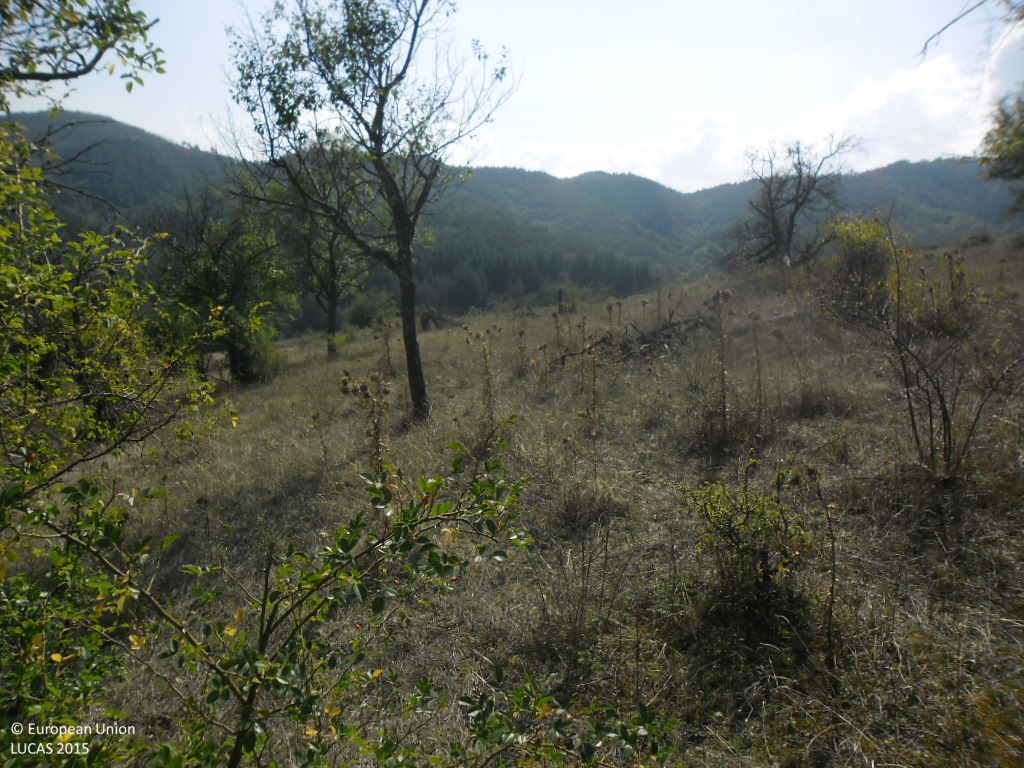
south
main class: Cropland
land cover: Other fruit trees and berries
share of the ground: 25 - 50 %
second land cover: Grassland without tree/shrub cover
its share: > 75 %
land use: Agriculture (excluding fallow land and kitchen gardens)
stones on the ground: < 10 %
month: September
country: BG
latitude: 41.8884
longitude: 22.9770
